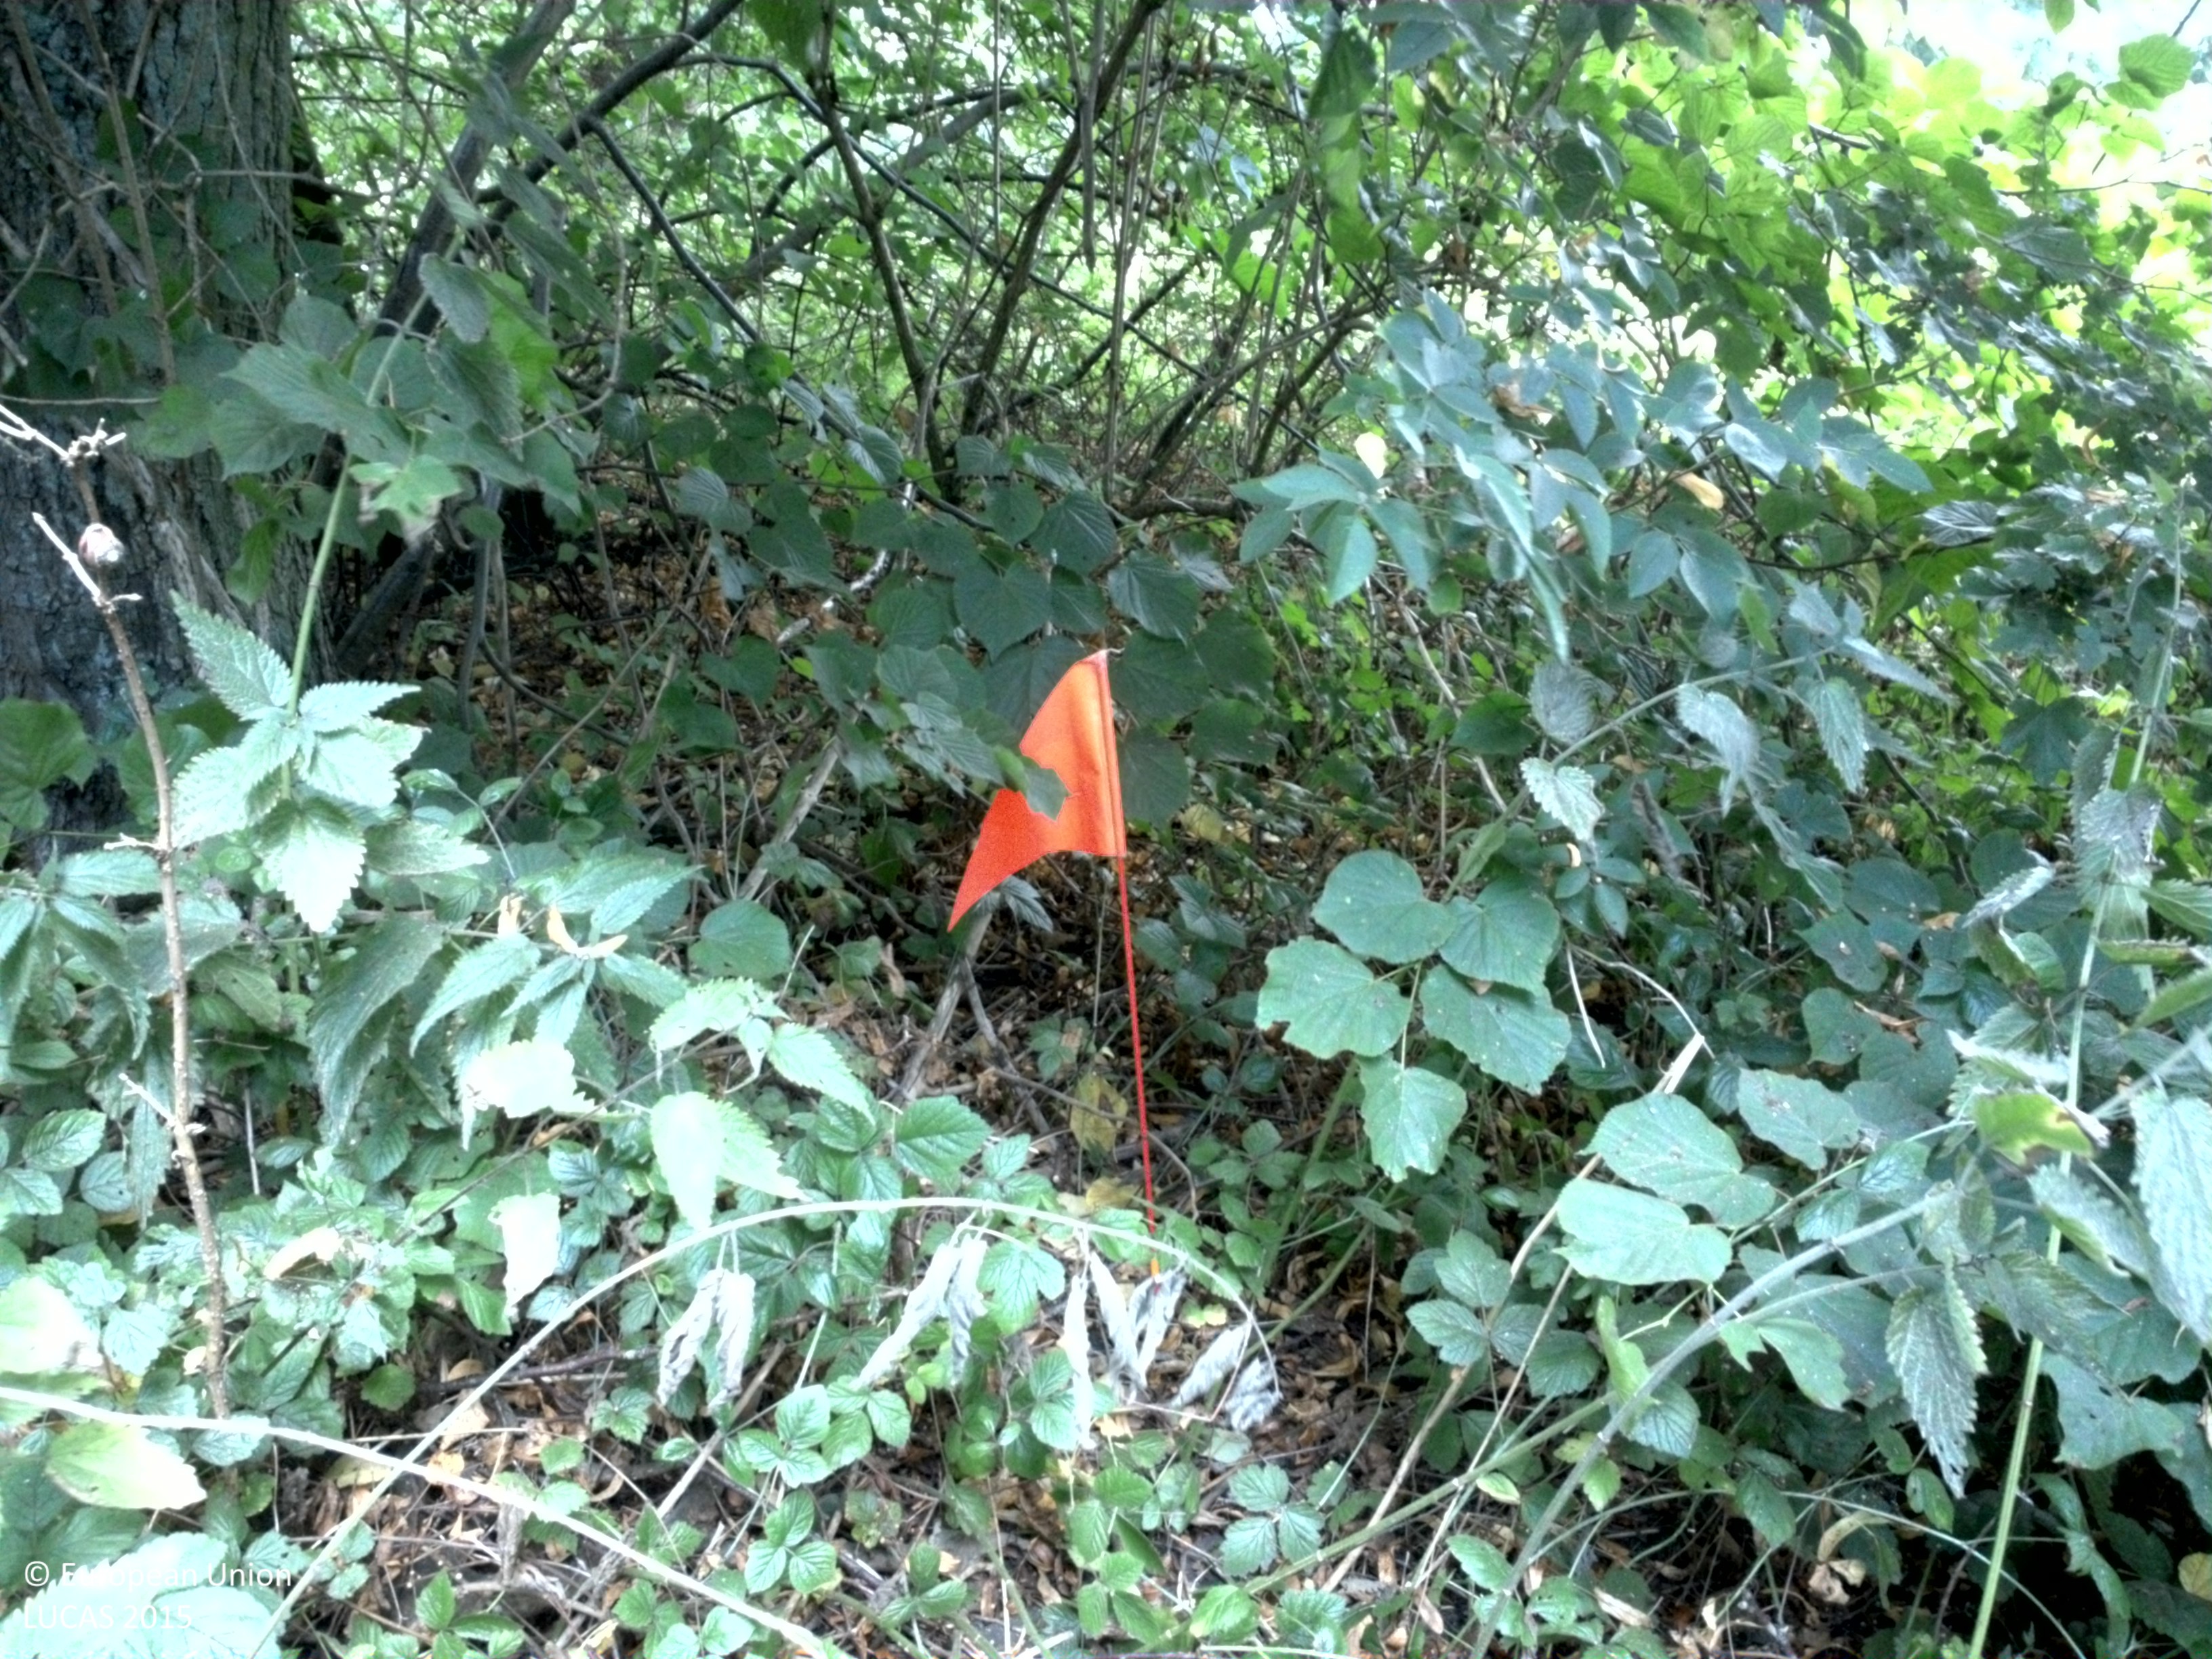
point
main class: Woodland
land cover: Broadleaved woodland
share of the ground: > 75 %
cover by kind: broadleaved forest trees 75 %, herbaceous plants 15 %, shrubs 10 %
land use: Residential
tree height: > 5 m
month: September
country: SE
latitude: 55.5262
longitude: 14.1649
